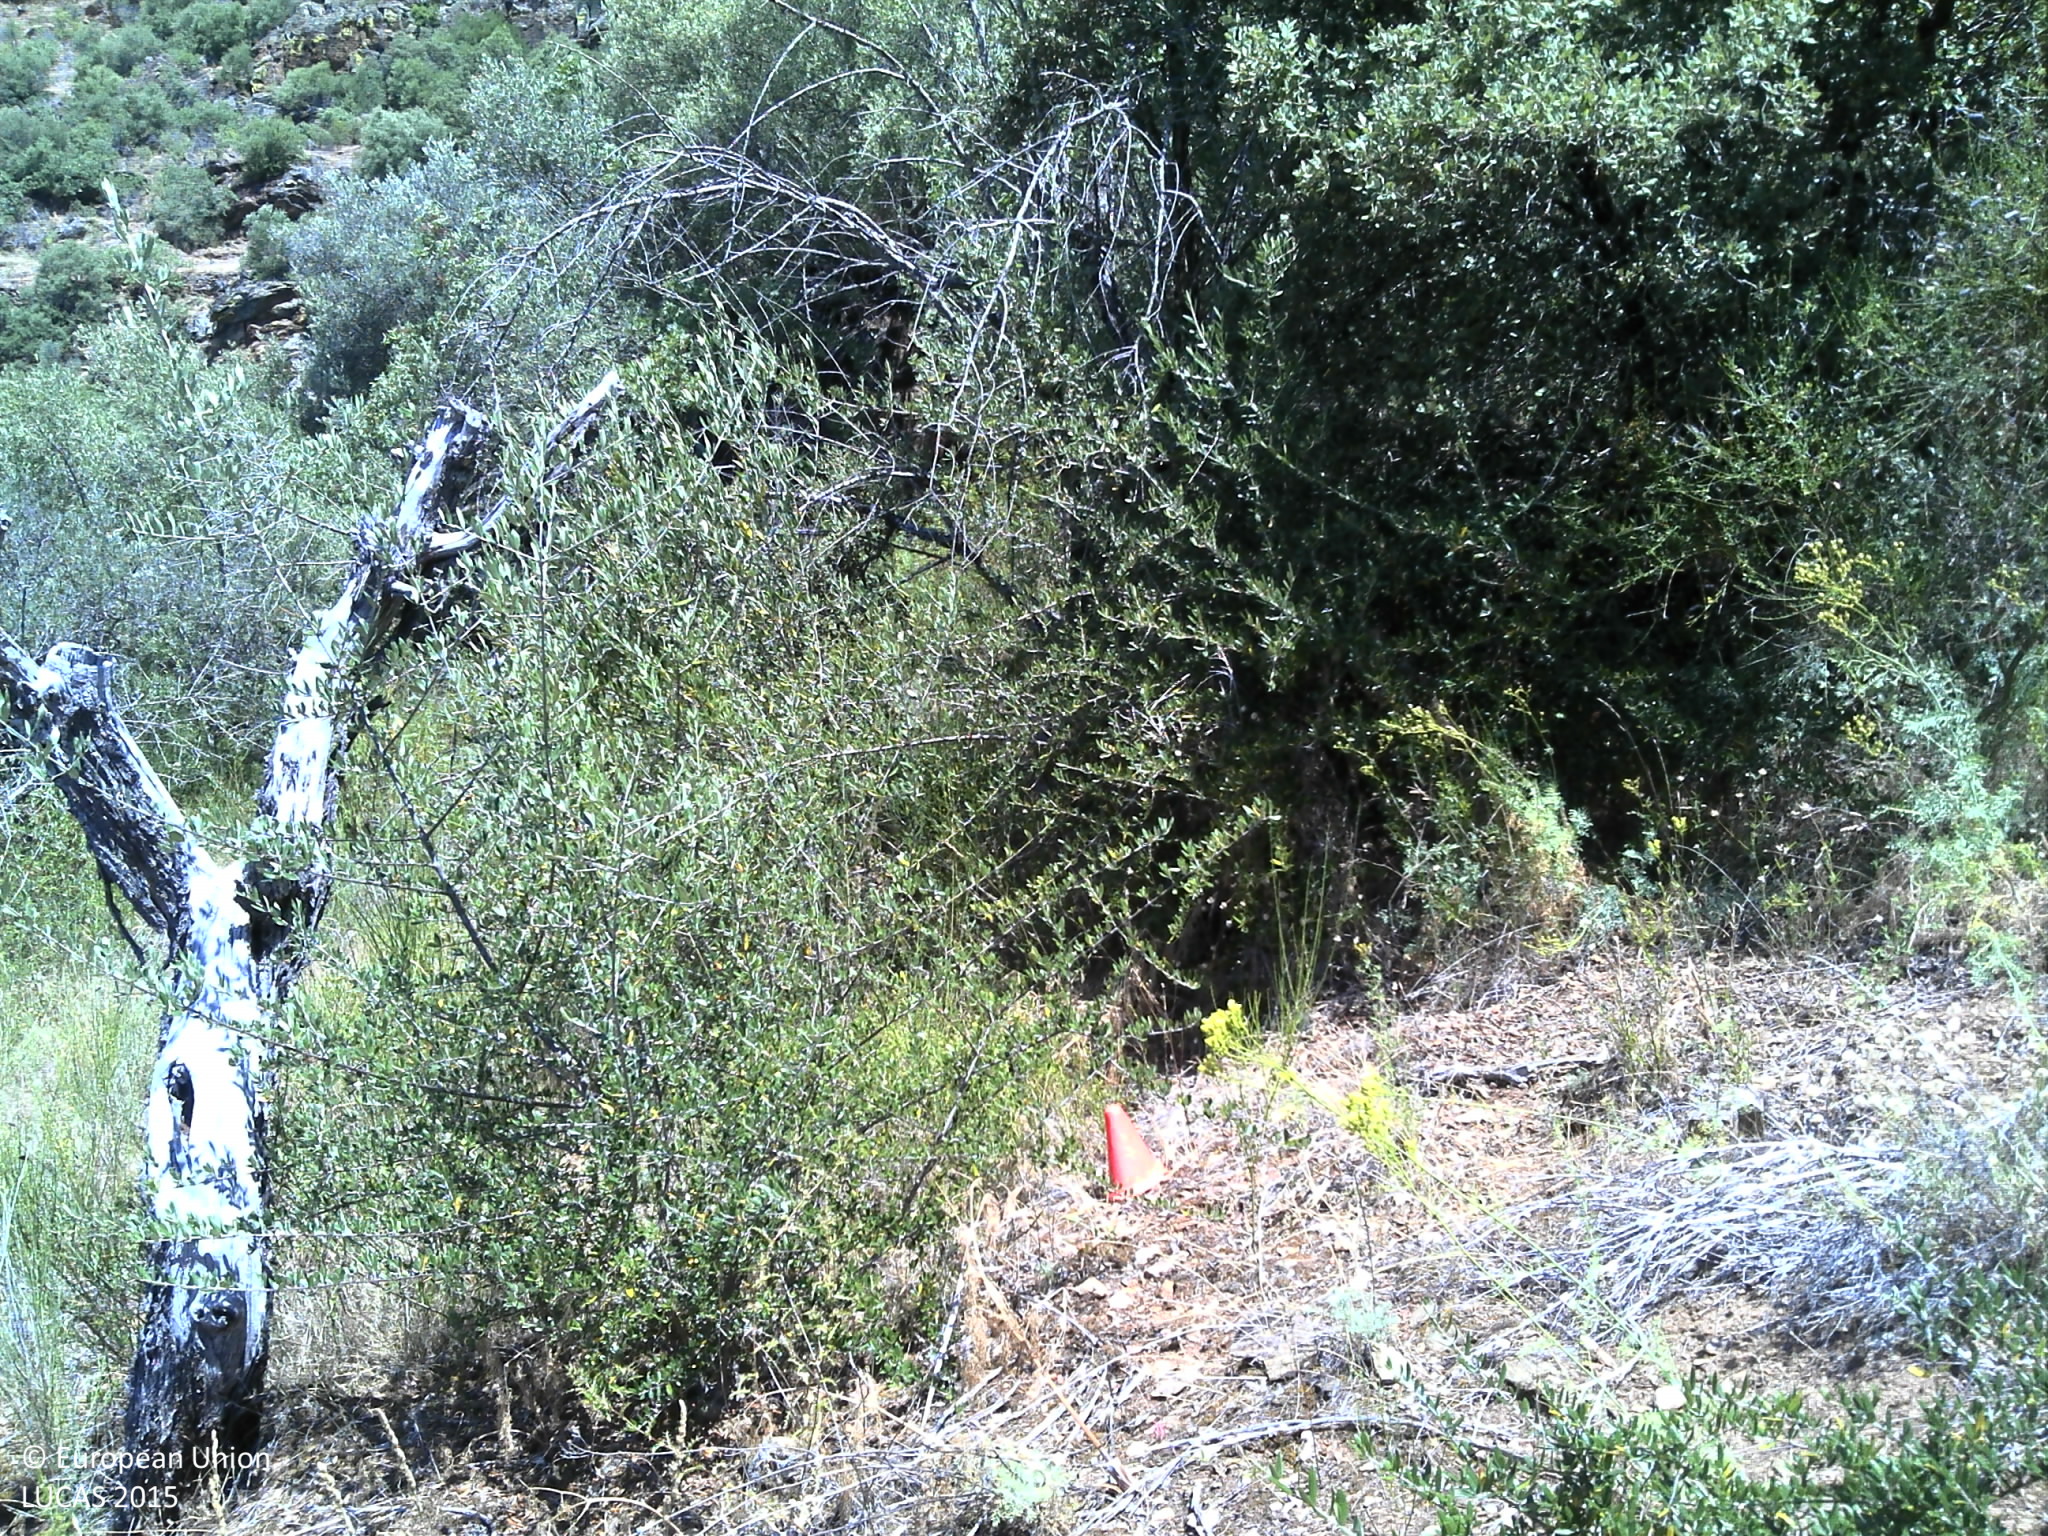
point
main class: Shrubland
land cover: Shrubland with sparse tree cover
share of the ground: 50 - 75 %
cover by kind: shrubs 75 %, unconsolidated bare surface 15 %, broadleaved forest trees 5 %, herbaceous plants 5 %
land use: Abandoned areas
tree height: > 5 m
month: June
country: PT
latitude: 41.2880
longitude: -6.8362
